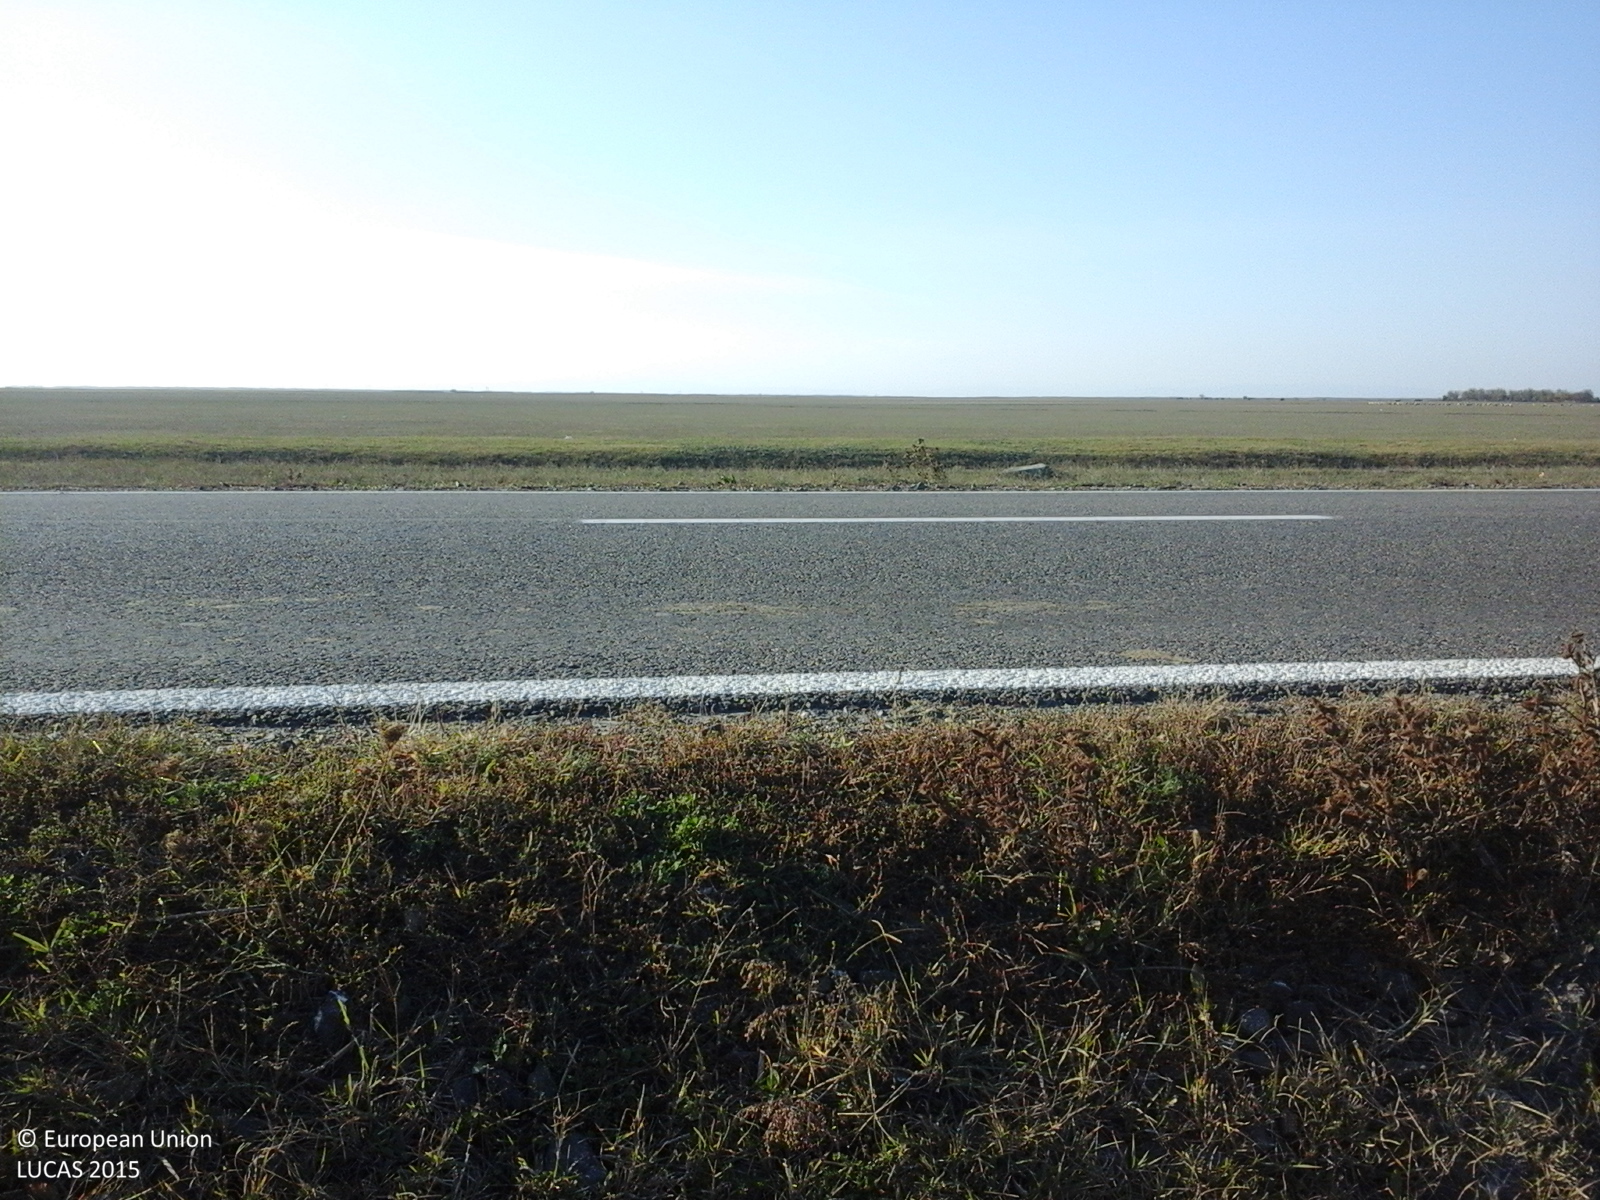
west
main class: Grassland
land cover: Grassland without tree/shrub cover
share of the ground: > 75 %
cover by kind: herbaceous plants 100 %
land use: Agriculture (excluding fallow land and kitchen gardens)
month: October
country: RO
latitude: 45.4417
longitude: 27.5279
